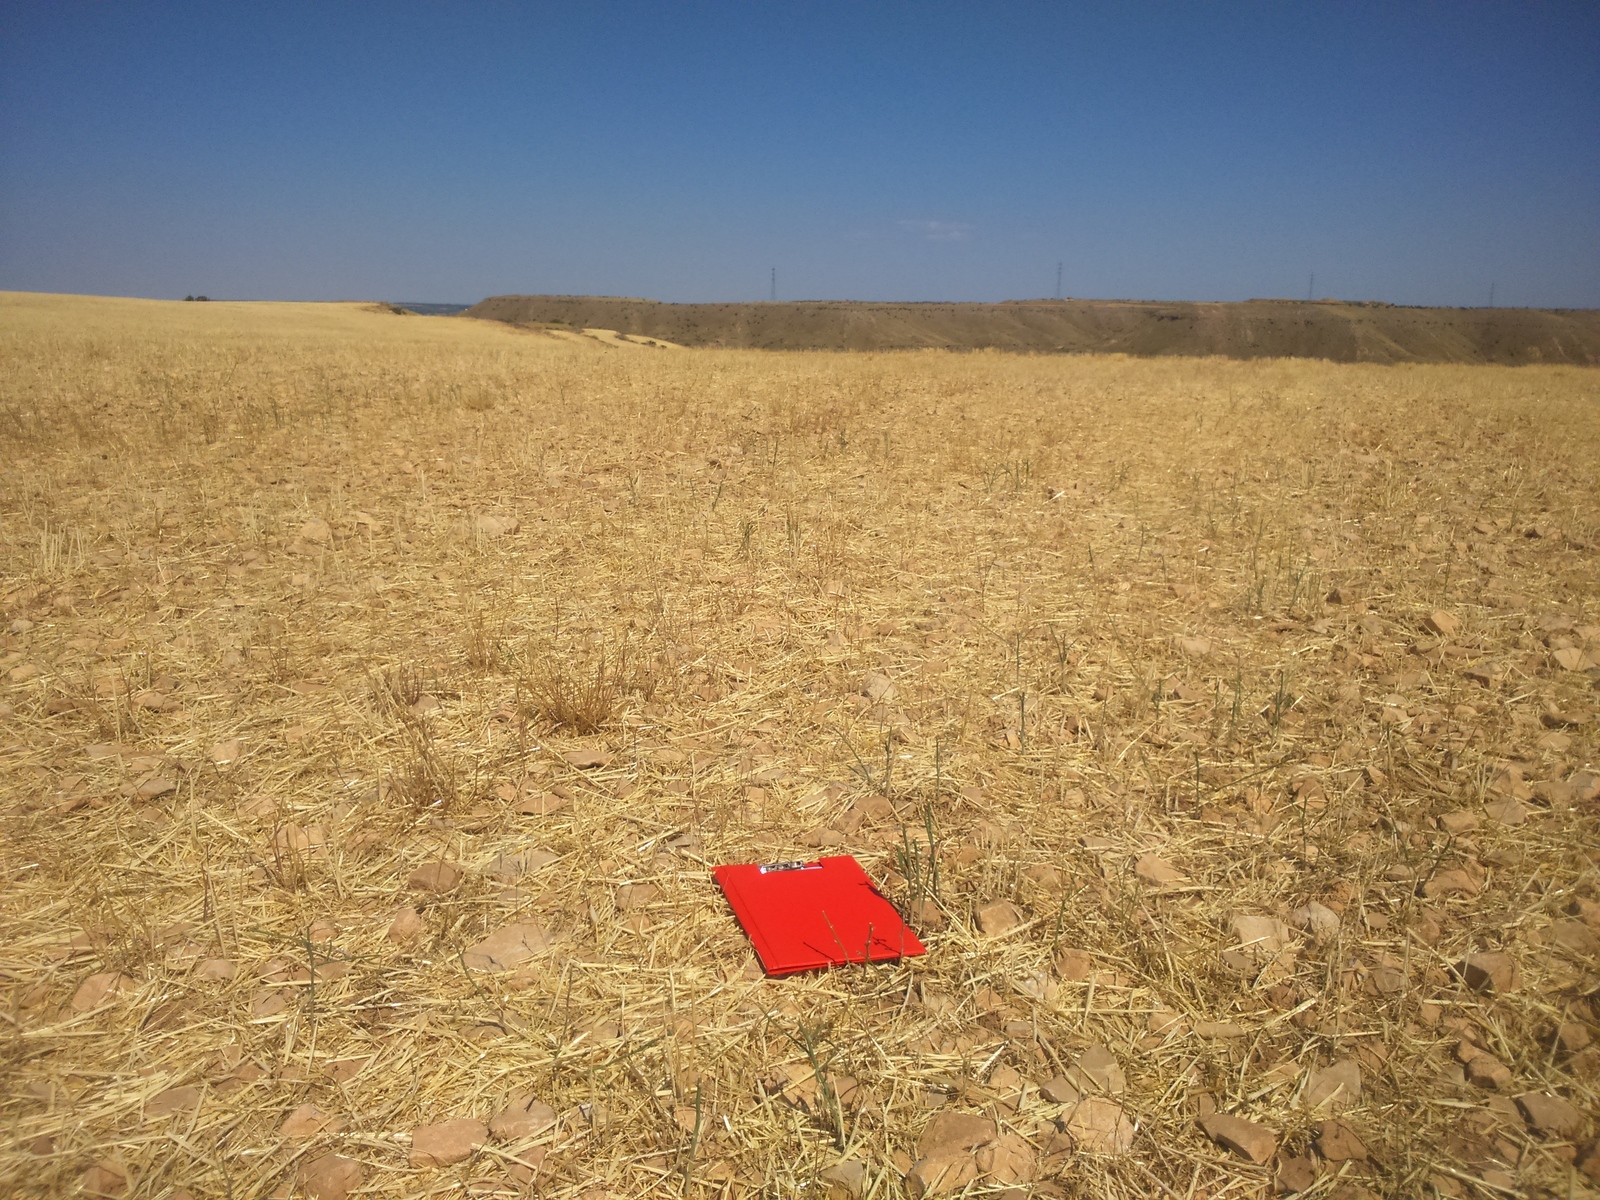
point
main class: Cropland
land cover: Barley
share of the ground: < 10 %
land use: Agriculture (excluding fallow land and kitchen gardens)
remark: Harvested field
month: June
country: ES
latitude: 41.6588
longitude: 0.1014
